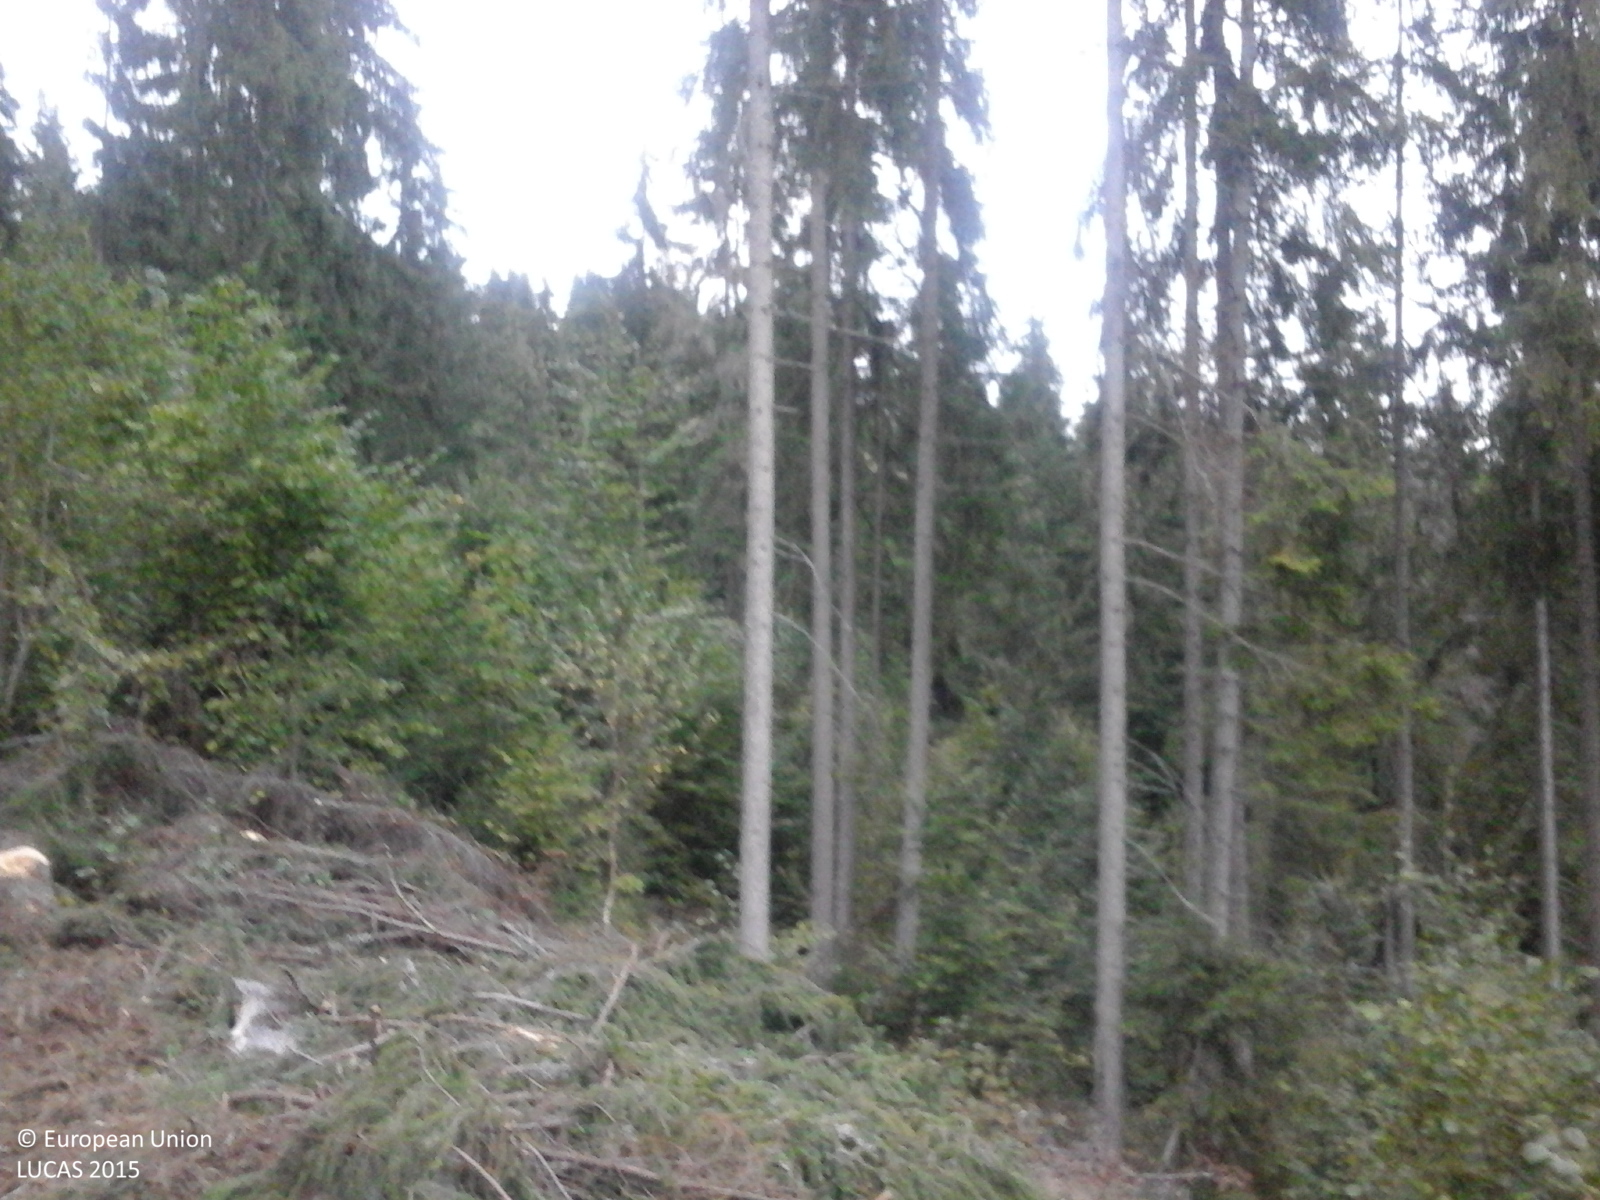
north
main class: Woodland
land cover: Spruce dominated mixed woodland
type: alpine coniferous forest
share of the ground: 50 - 75 %
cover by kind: coniferous forest trees 40 %, broadleaved forest trees 30 %, unconsolidated bare surface 10 %, shrubs 5 %, herbaceous plants 5 %
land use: Forestry
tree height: > 5 m
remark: Clear cut
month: September
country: RO
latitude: 46.5084
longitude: 22.9474
